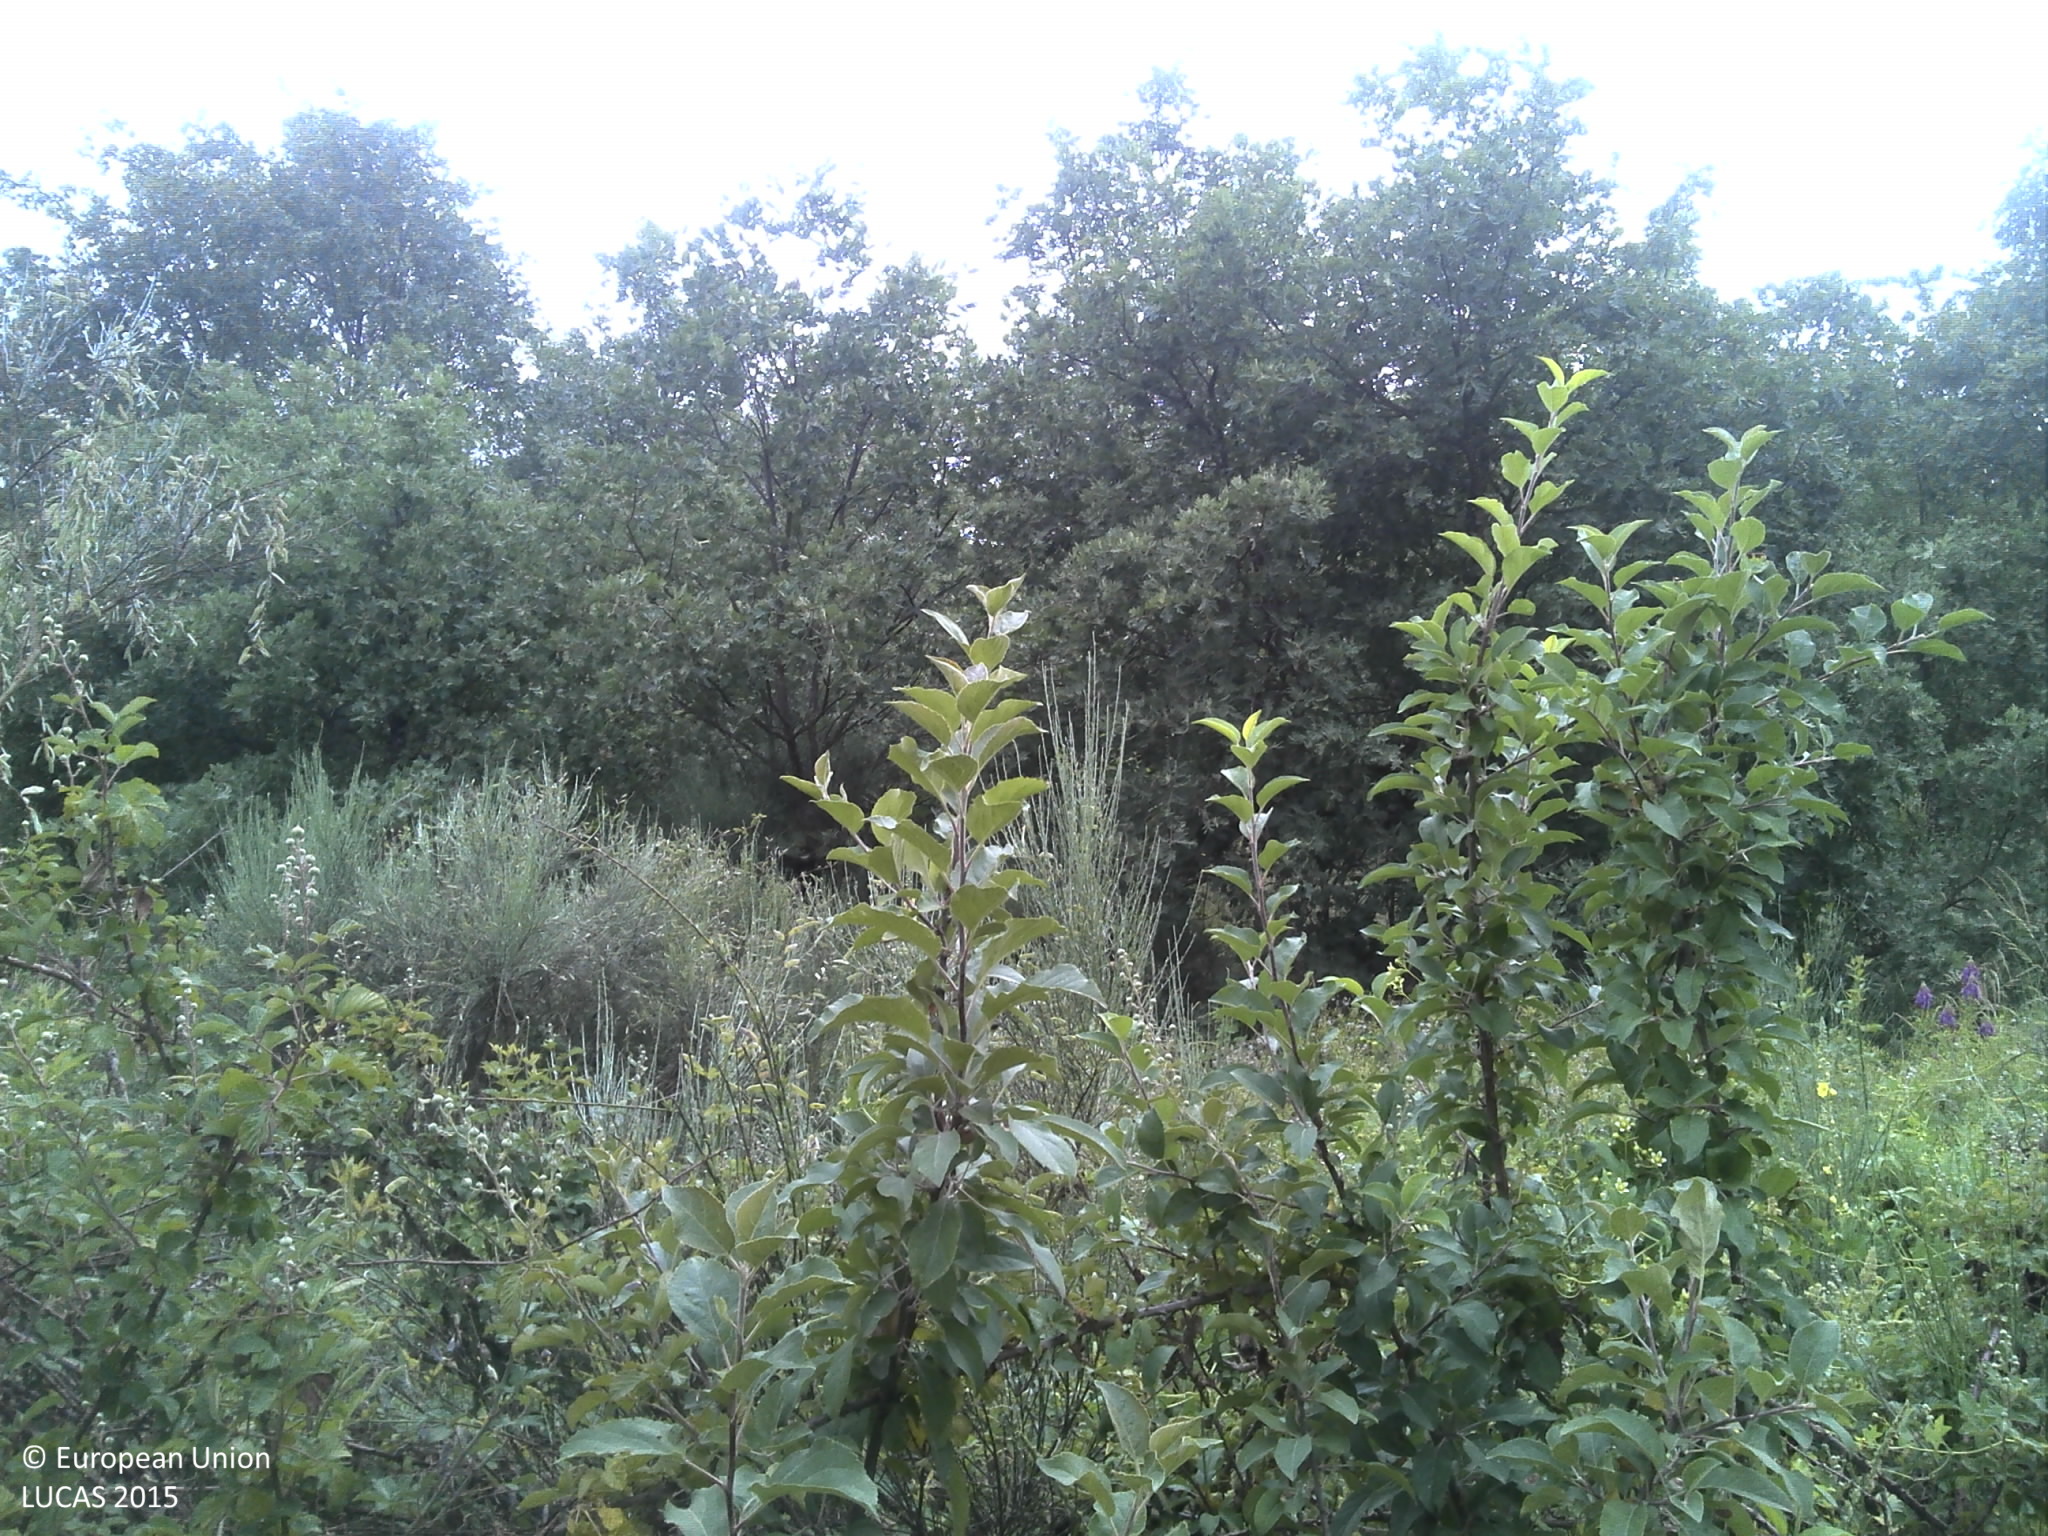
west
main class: Woodland
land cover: Broadleaved woodland
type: acidophilous oak and oak-birch forest
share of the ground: 25 - 50 %
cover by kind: broadleaved forest trees 50 %, shrubs 30 %, unconsolidated bare surface 15 %
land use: Forestry
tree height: > 5 m
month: June
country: PT
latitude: 40.2847
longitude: -7.4073
